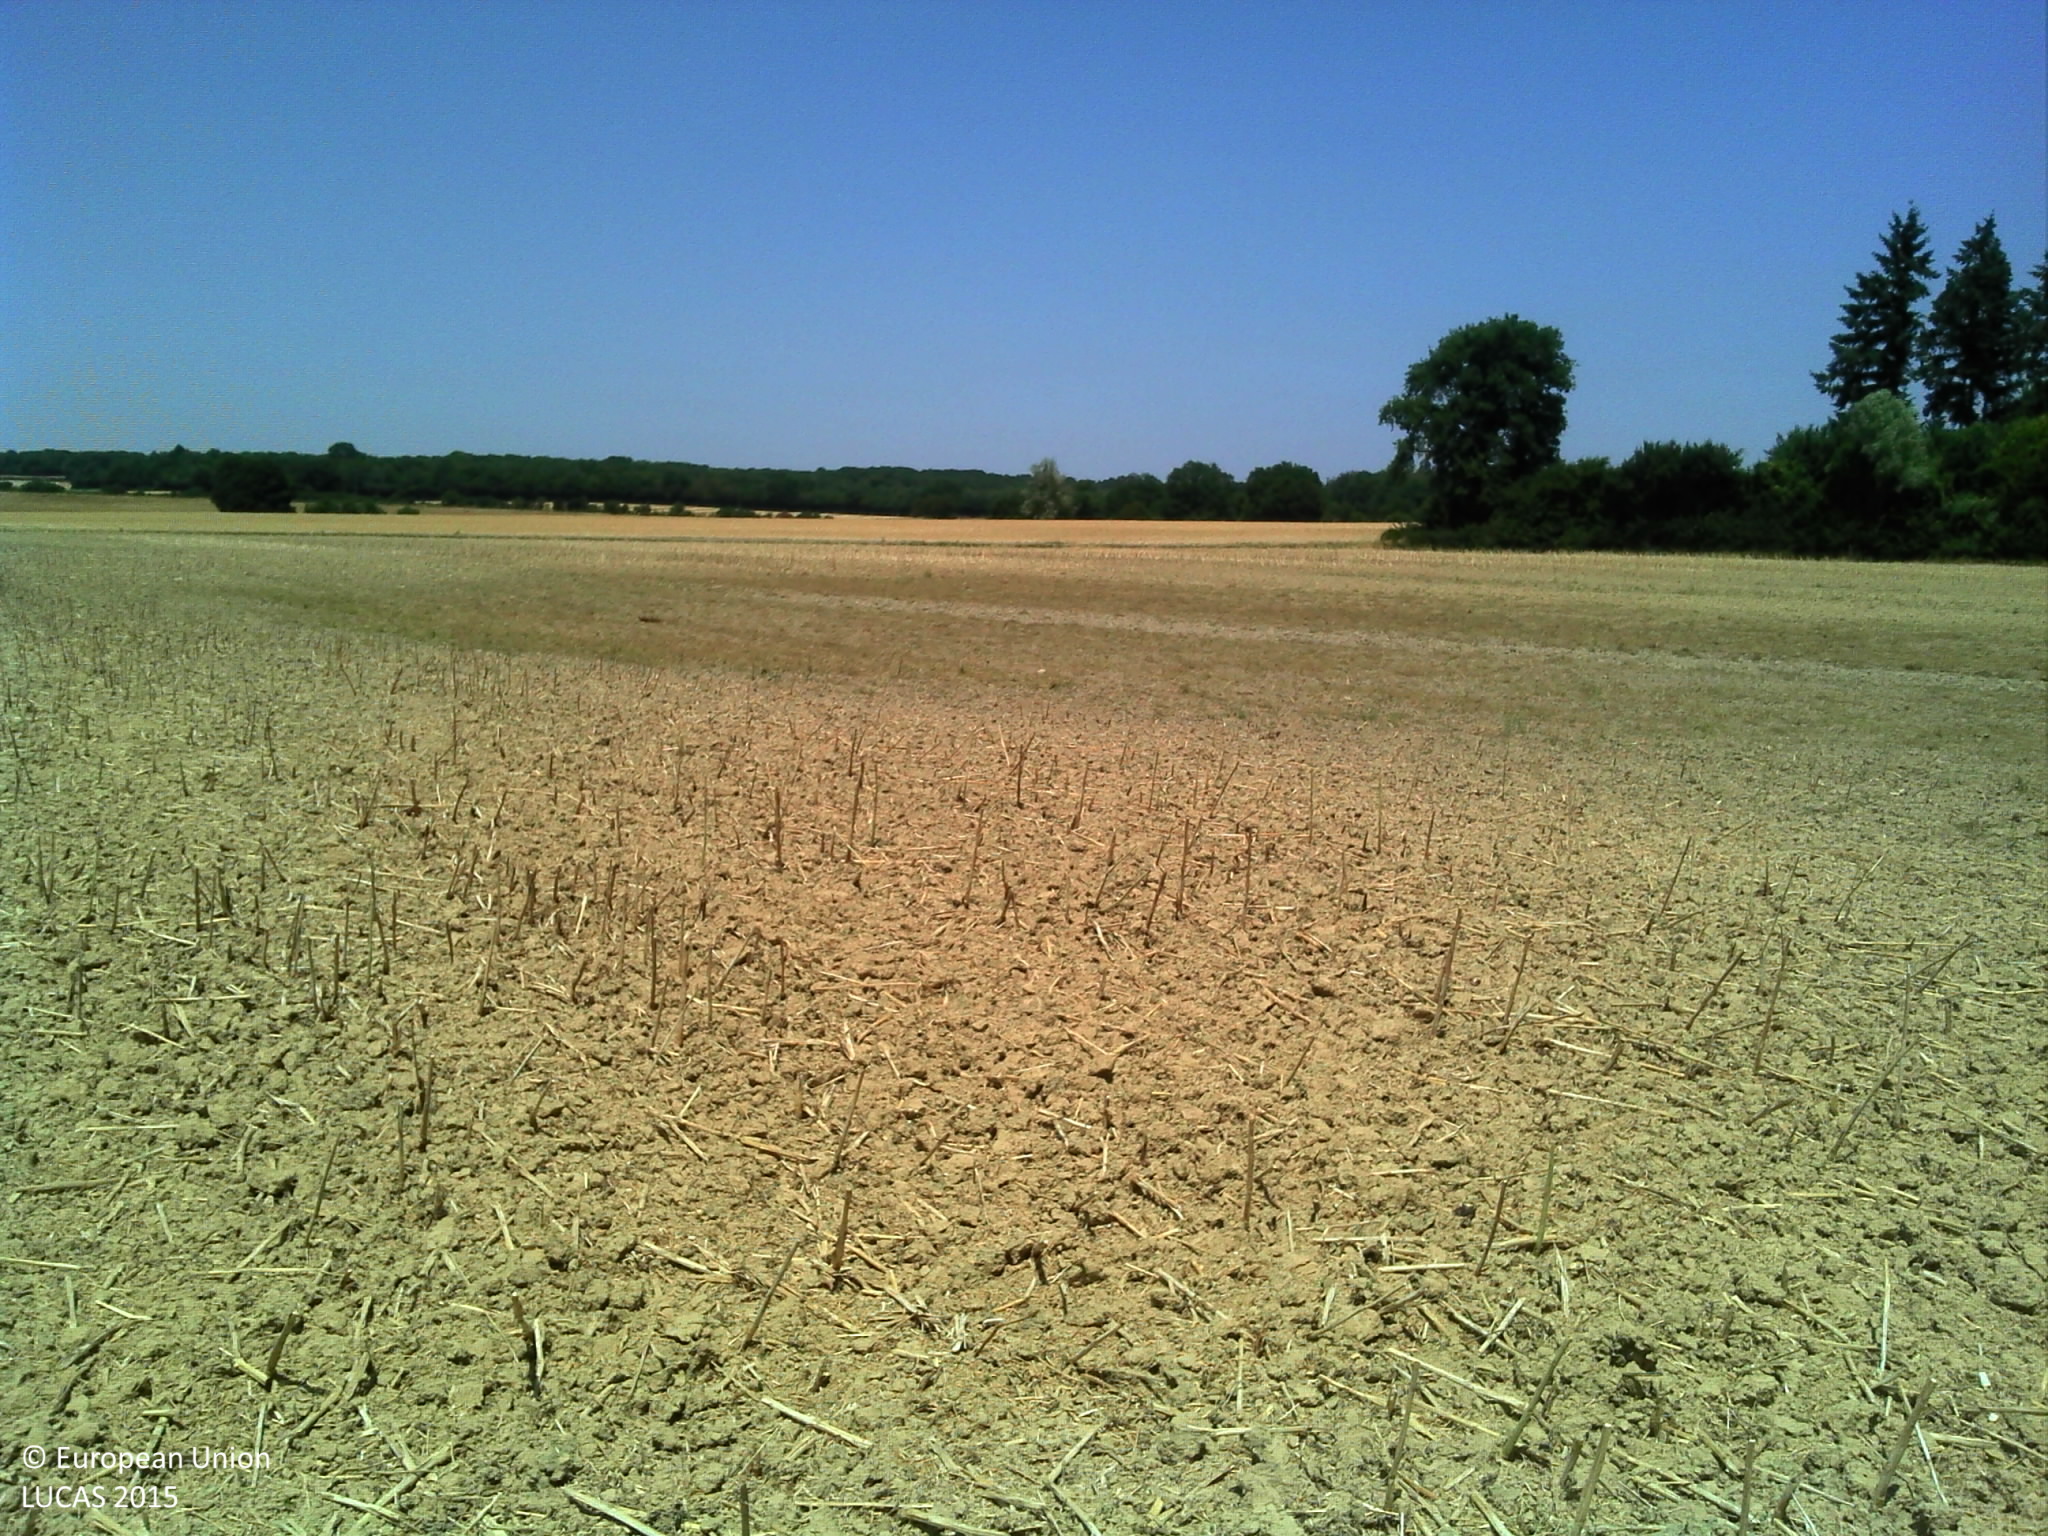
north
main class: Cropland
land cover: Rape and turnip rape
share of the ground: > 75 %
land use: Agriculture (excluding fallow land and kitchen gardens)
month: July
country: FR
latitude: 47.0095
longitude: 3.6184
